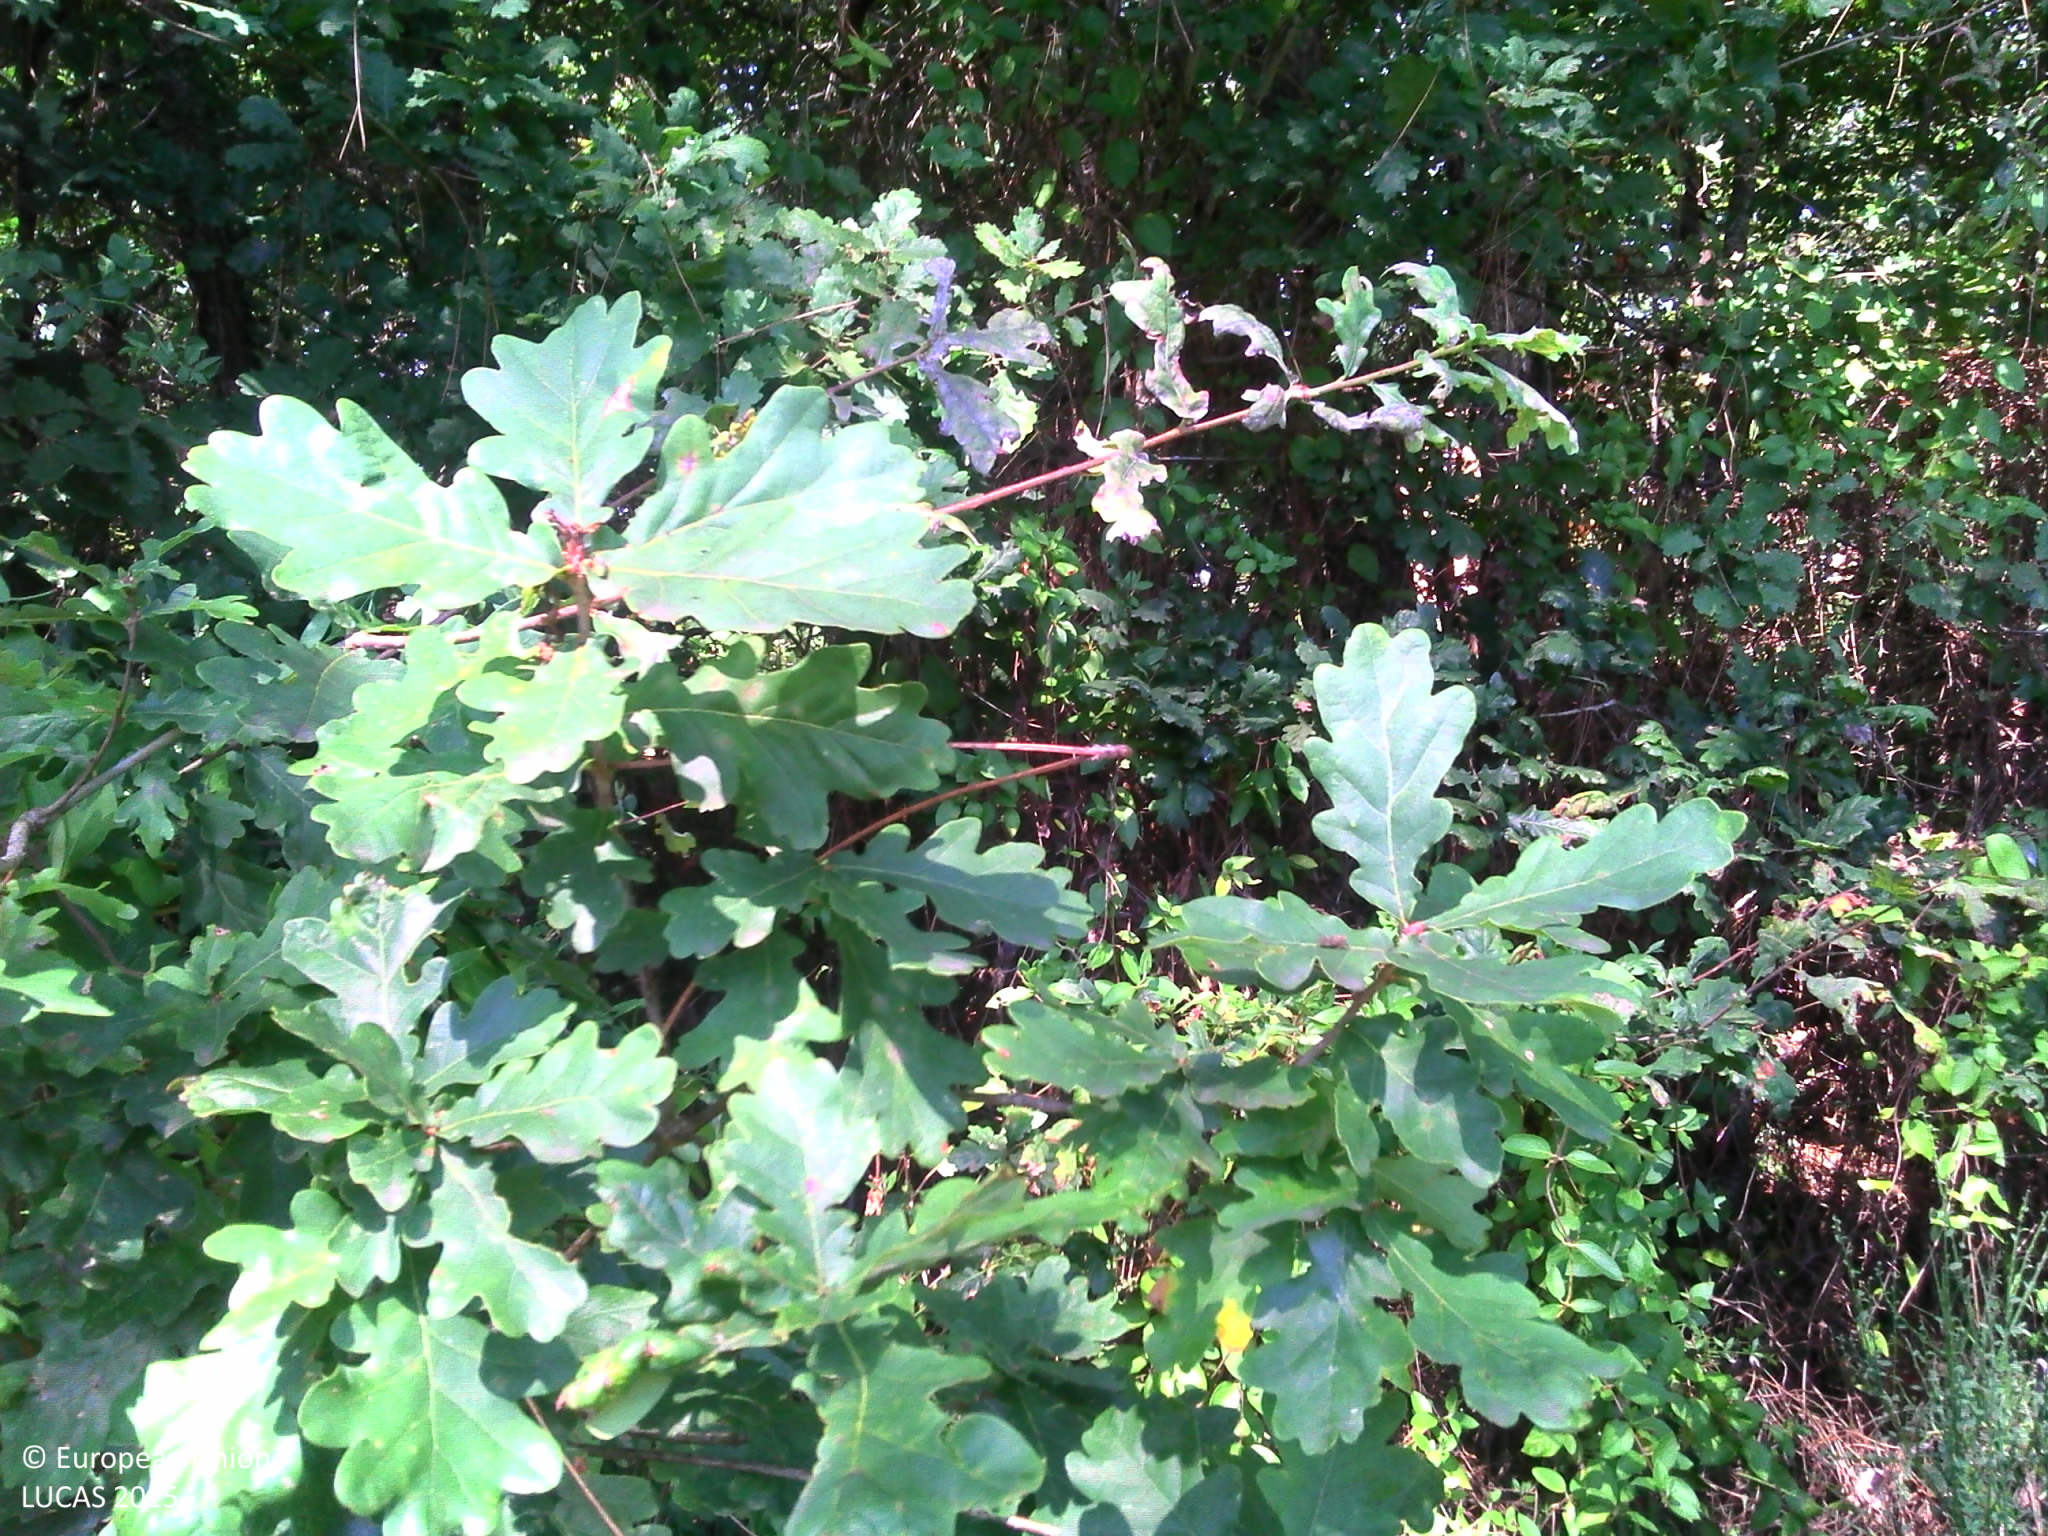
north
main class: Woodland
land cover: Pine dominated mixed woodland
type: coniferous forest of the mediterranean region
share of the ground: > 75 %
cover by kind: broadleaved forest trees 60 %, coniferous forest trees 30 %, shrubs 10 %
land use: Forestry
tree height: > 5 m
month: August
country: FR
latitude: 44.6076
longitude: 1.1631
